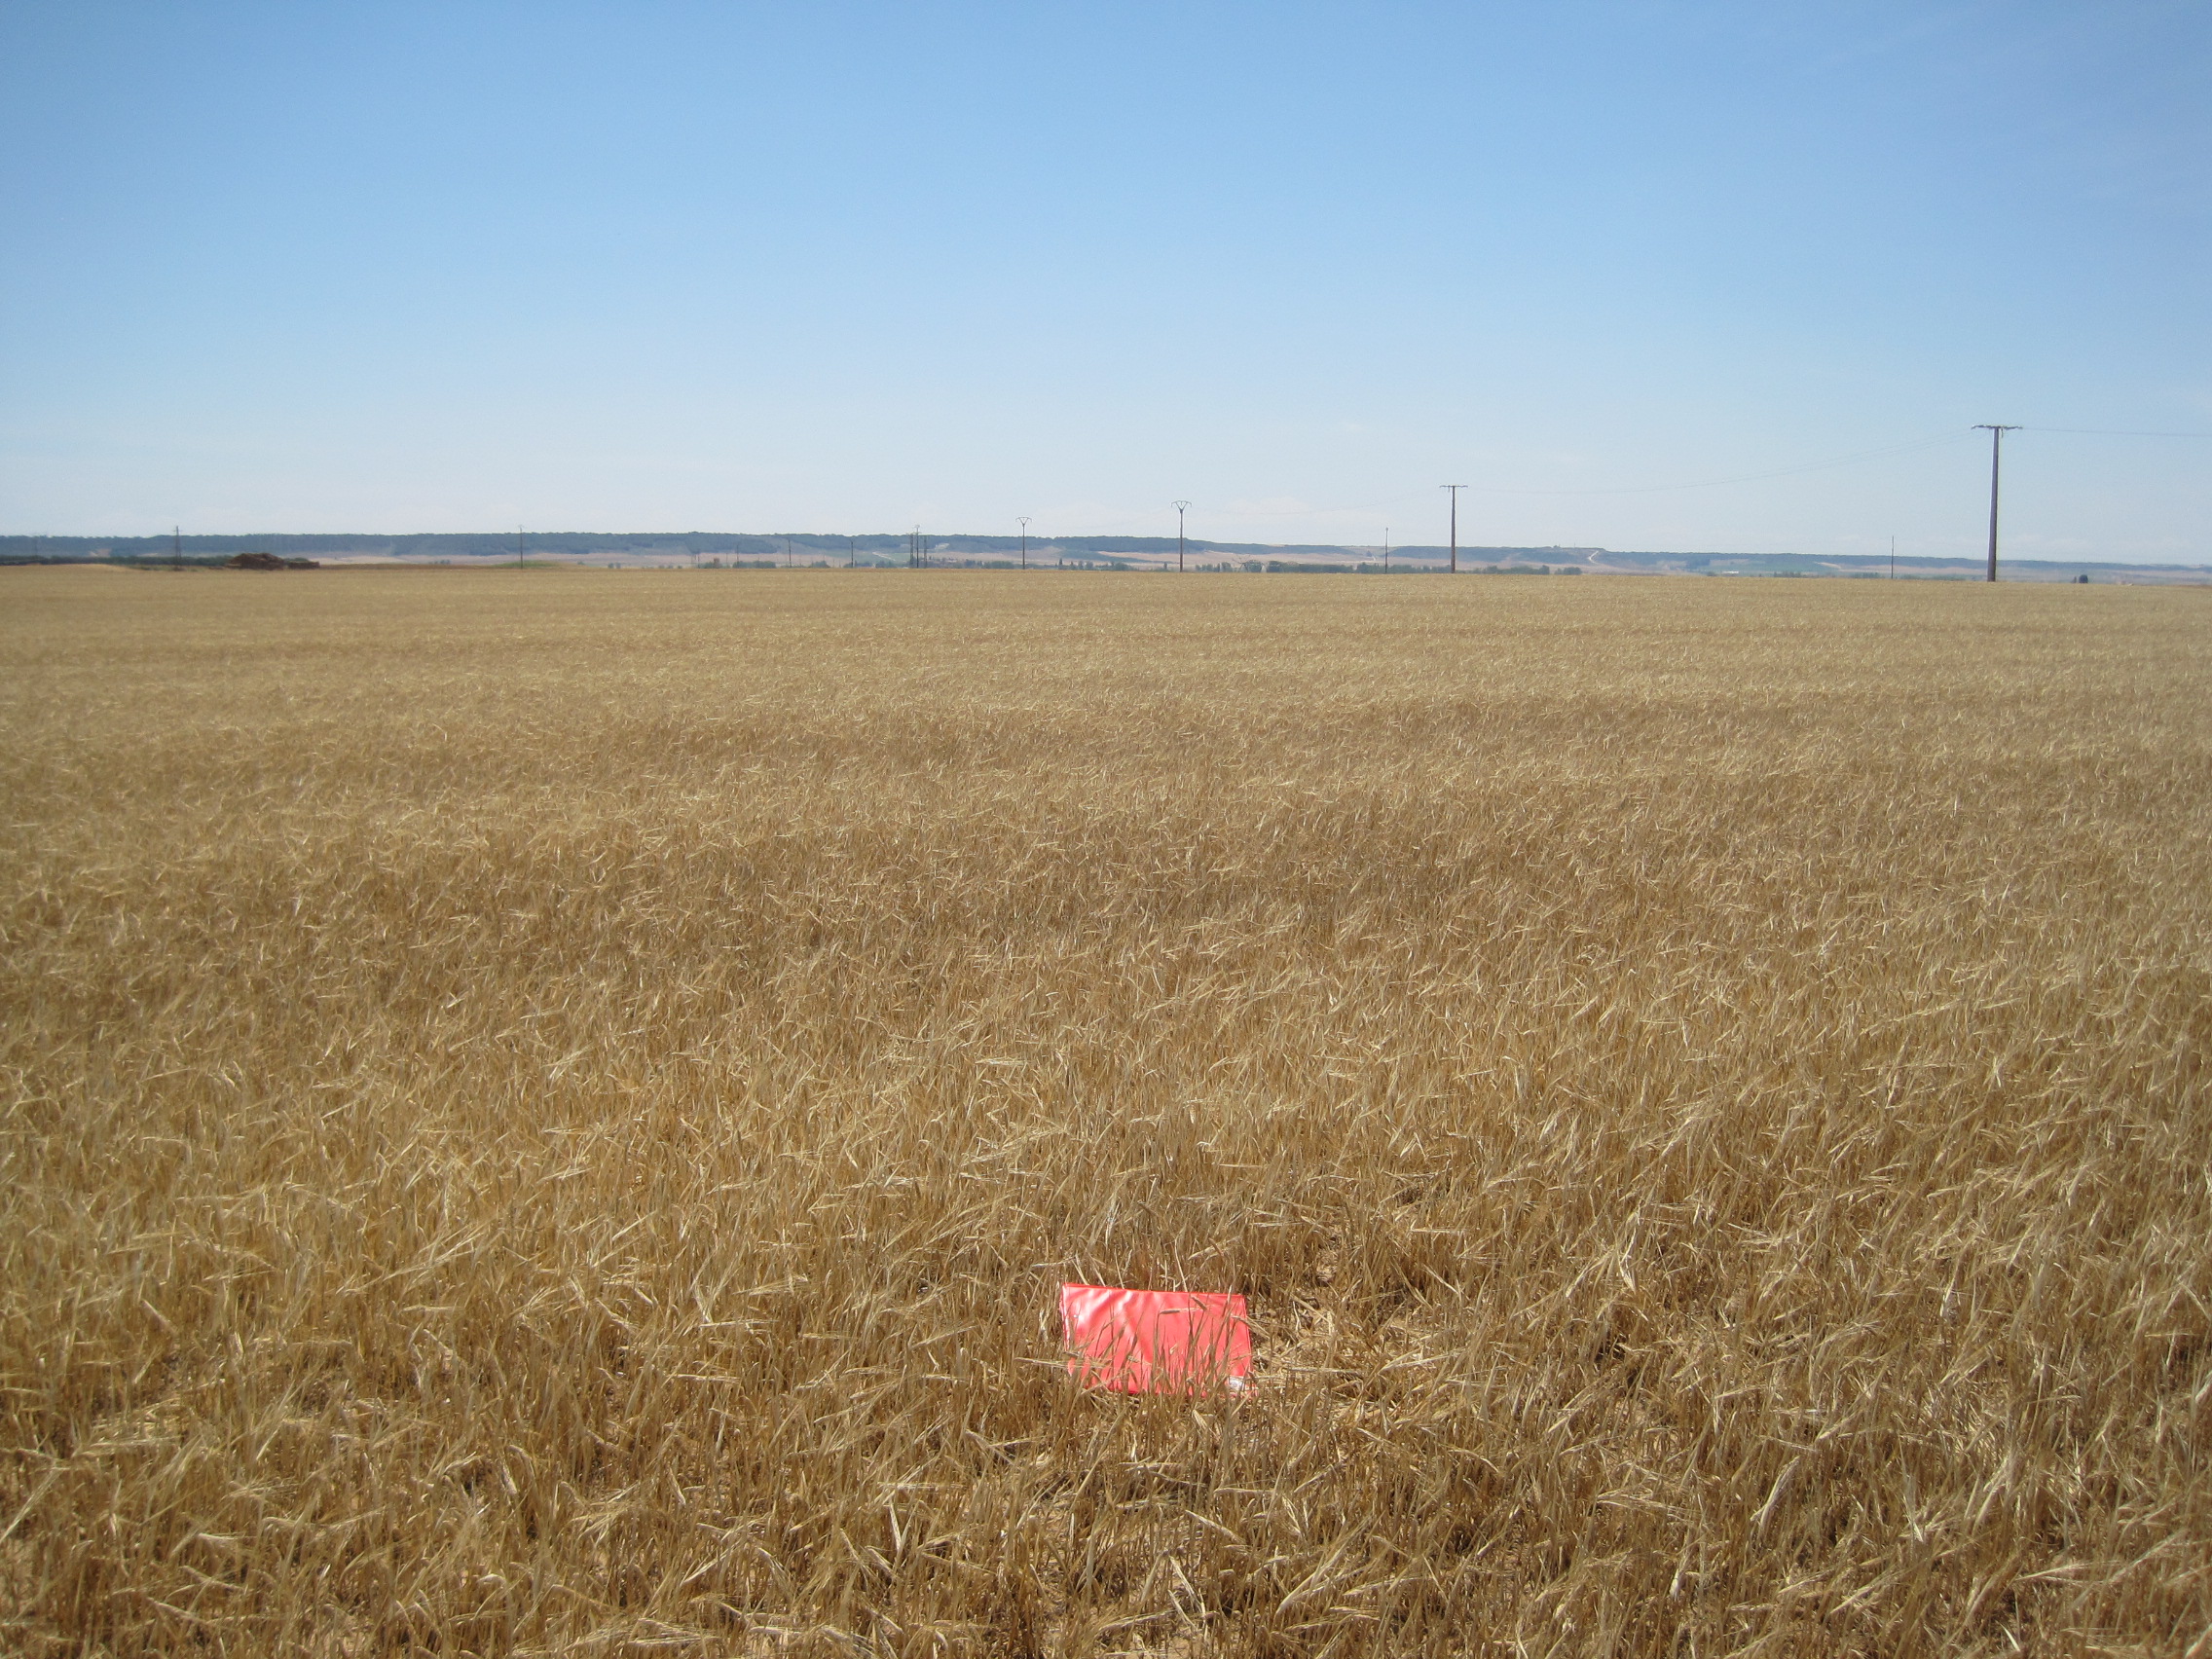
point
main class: Cropland
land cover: Barley
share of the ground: > 75 %
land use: Agriculture (excluding fallow land and kitchen gardens)
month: June
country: ES
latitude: 41.8270
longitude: -5.2149
